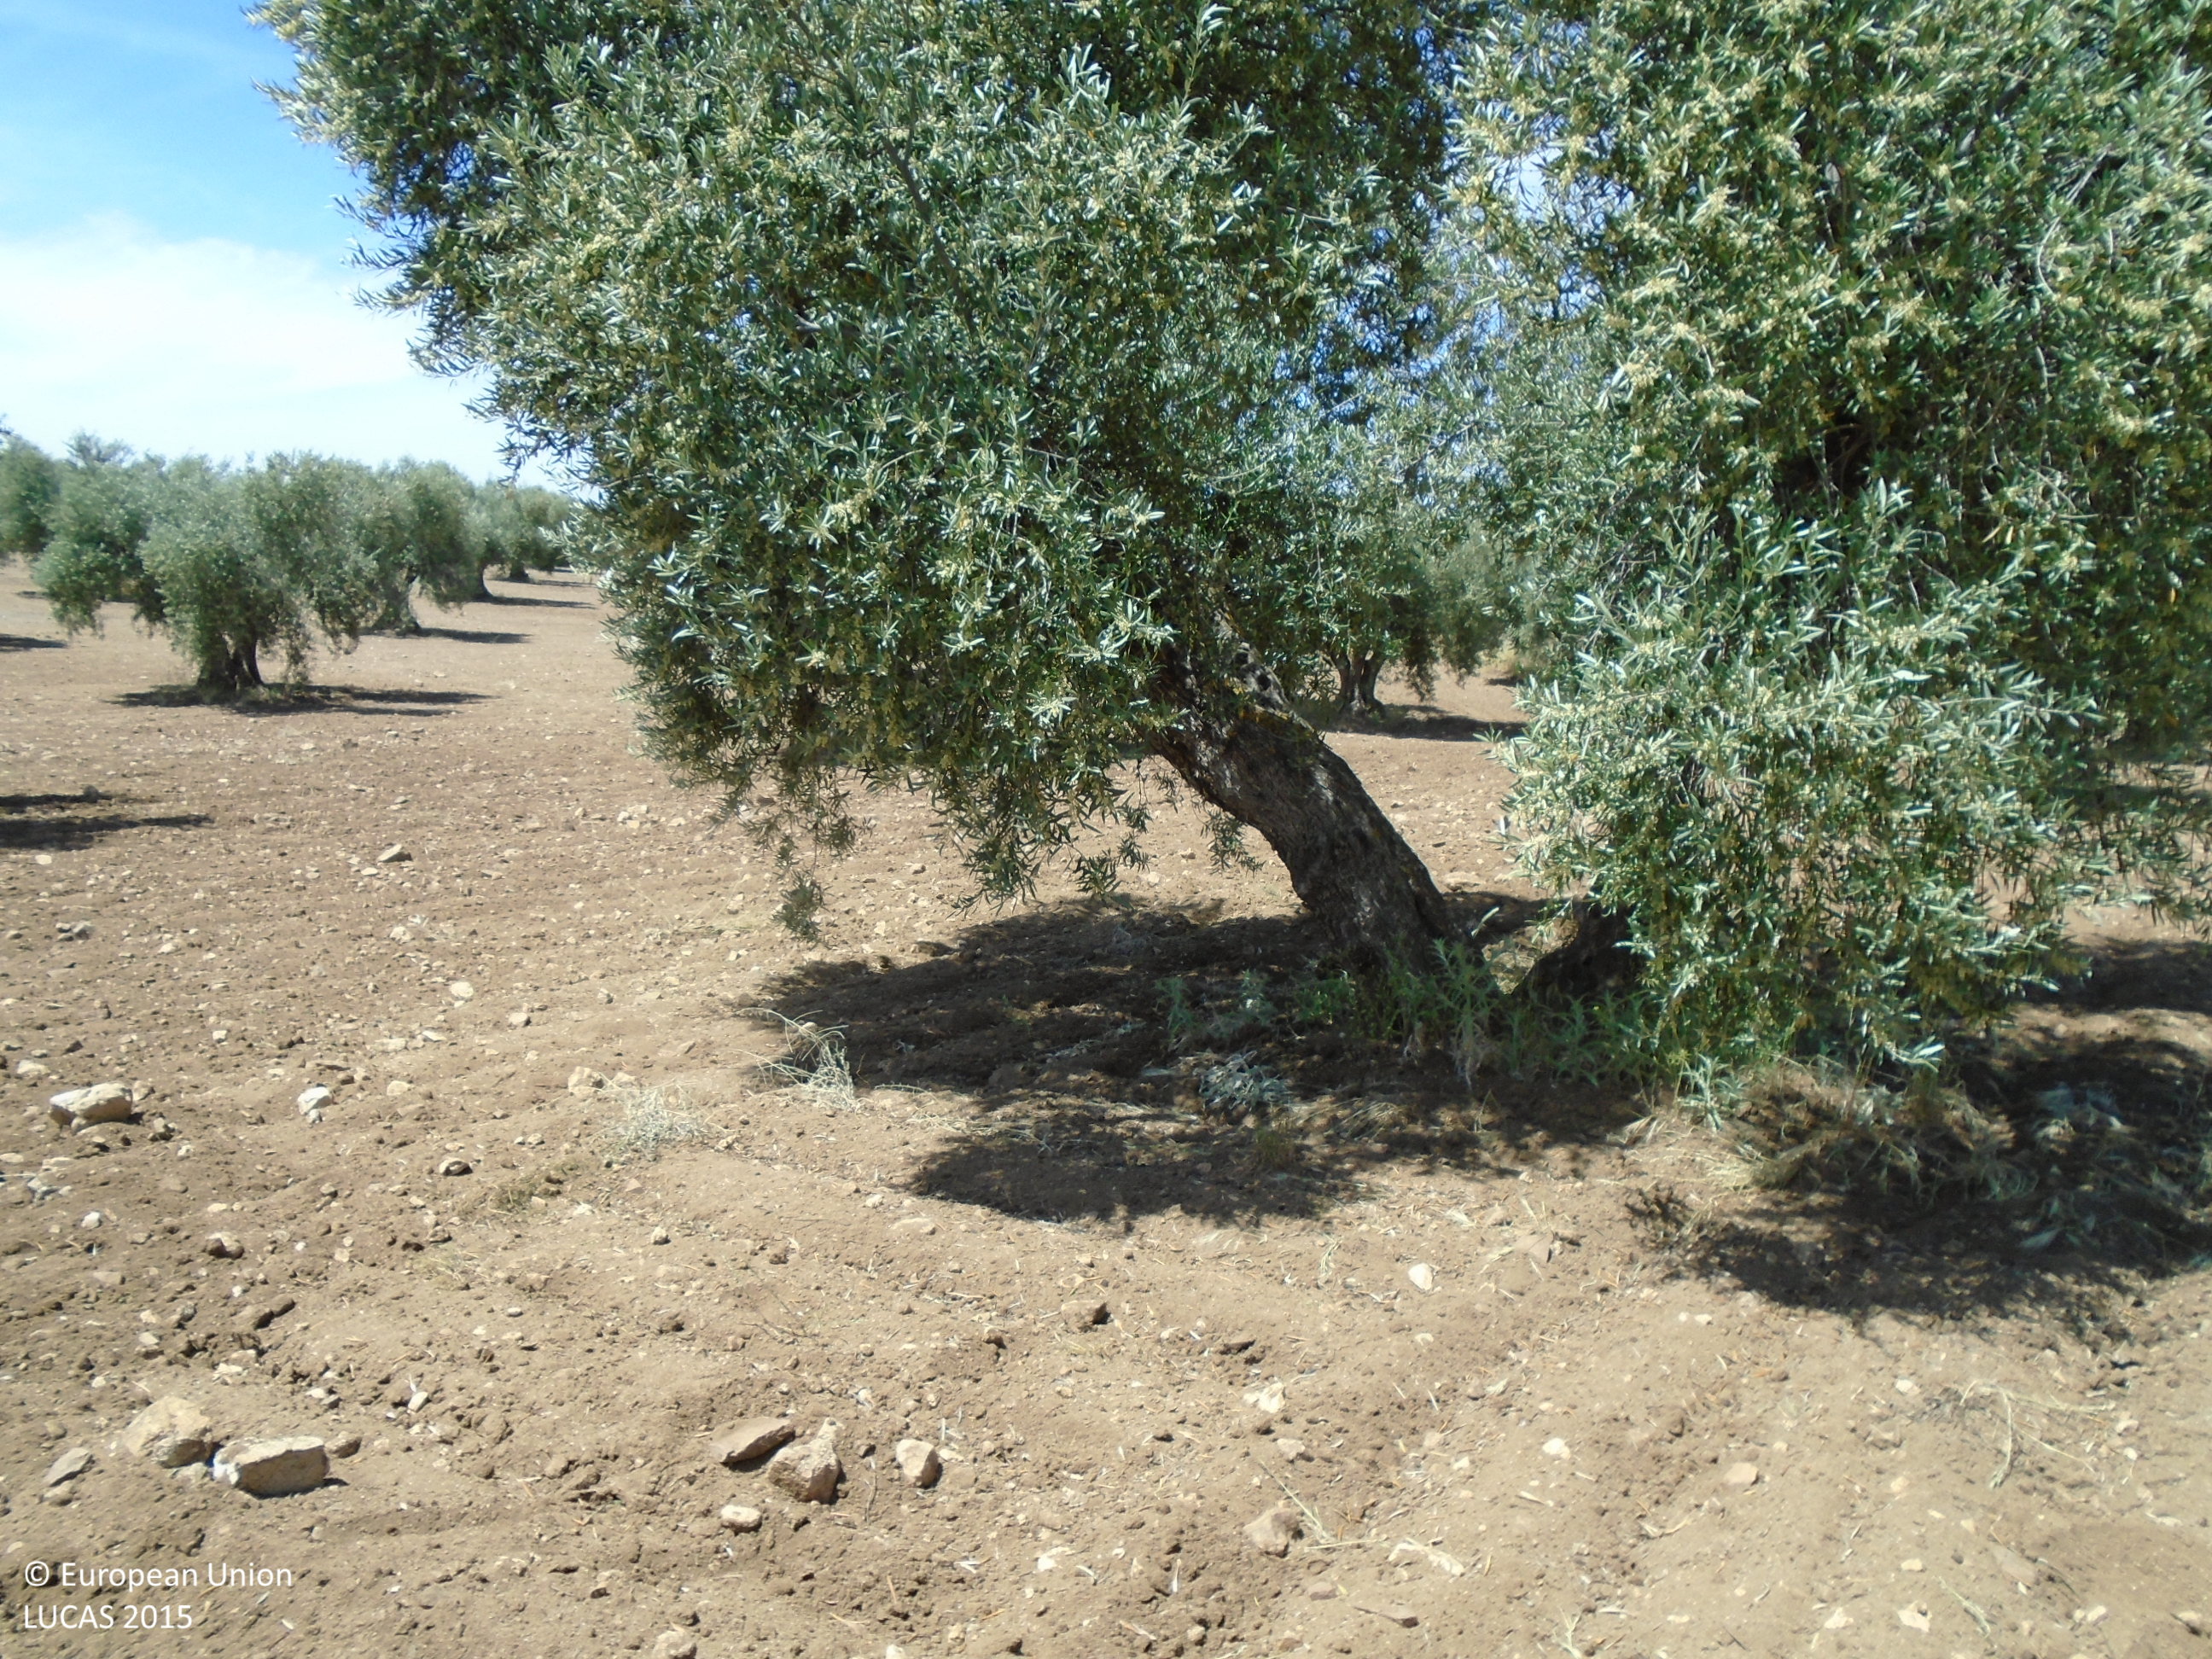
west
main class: Cropland
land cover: Olive groves
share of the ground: 10 - 25 %
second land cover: Other bare soil
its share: > 75 %
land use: Agriculture (excluding fallow land and kitchen gardens)
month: May
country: ES
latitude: 39.7822
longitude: -3.7966
